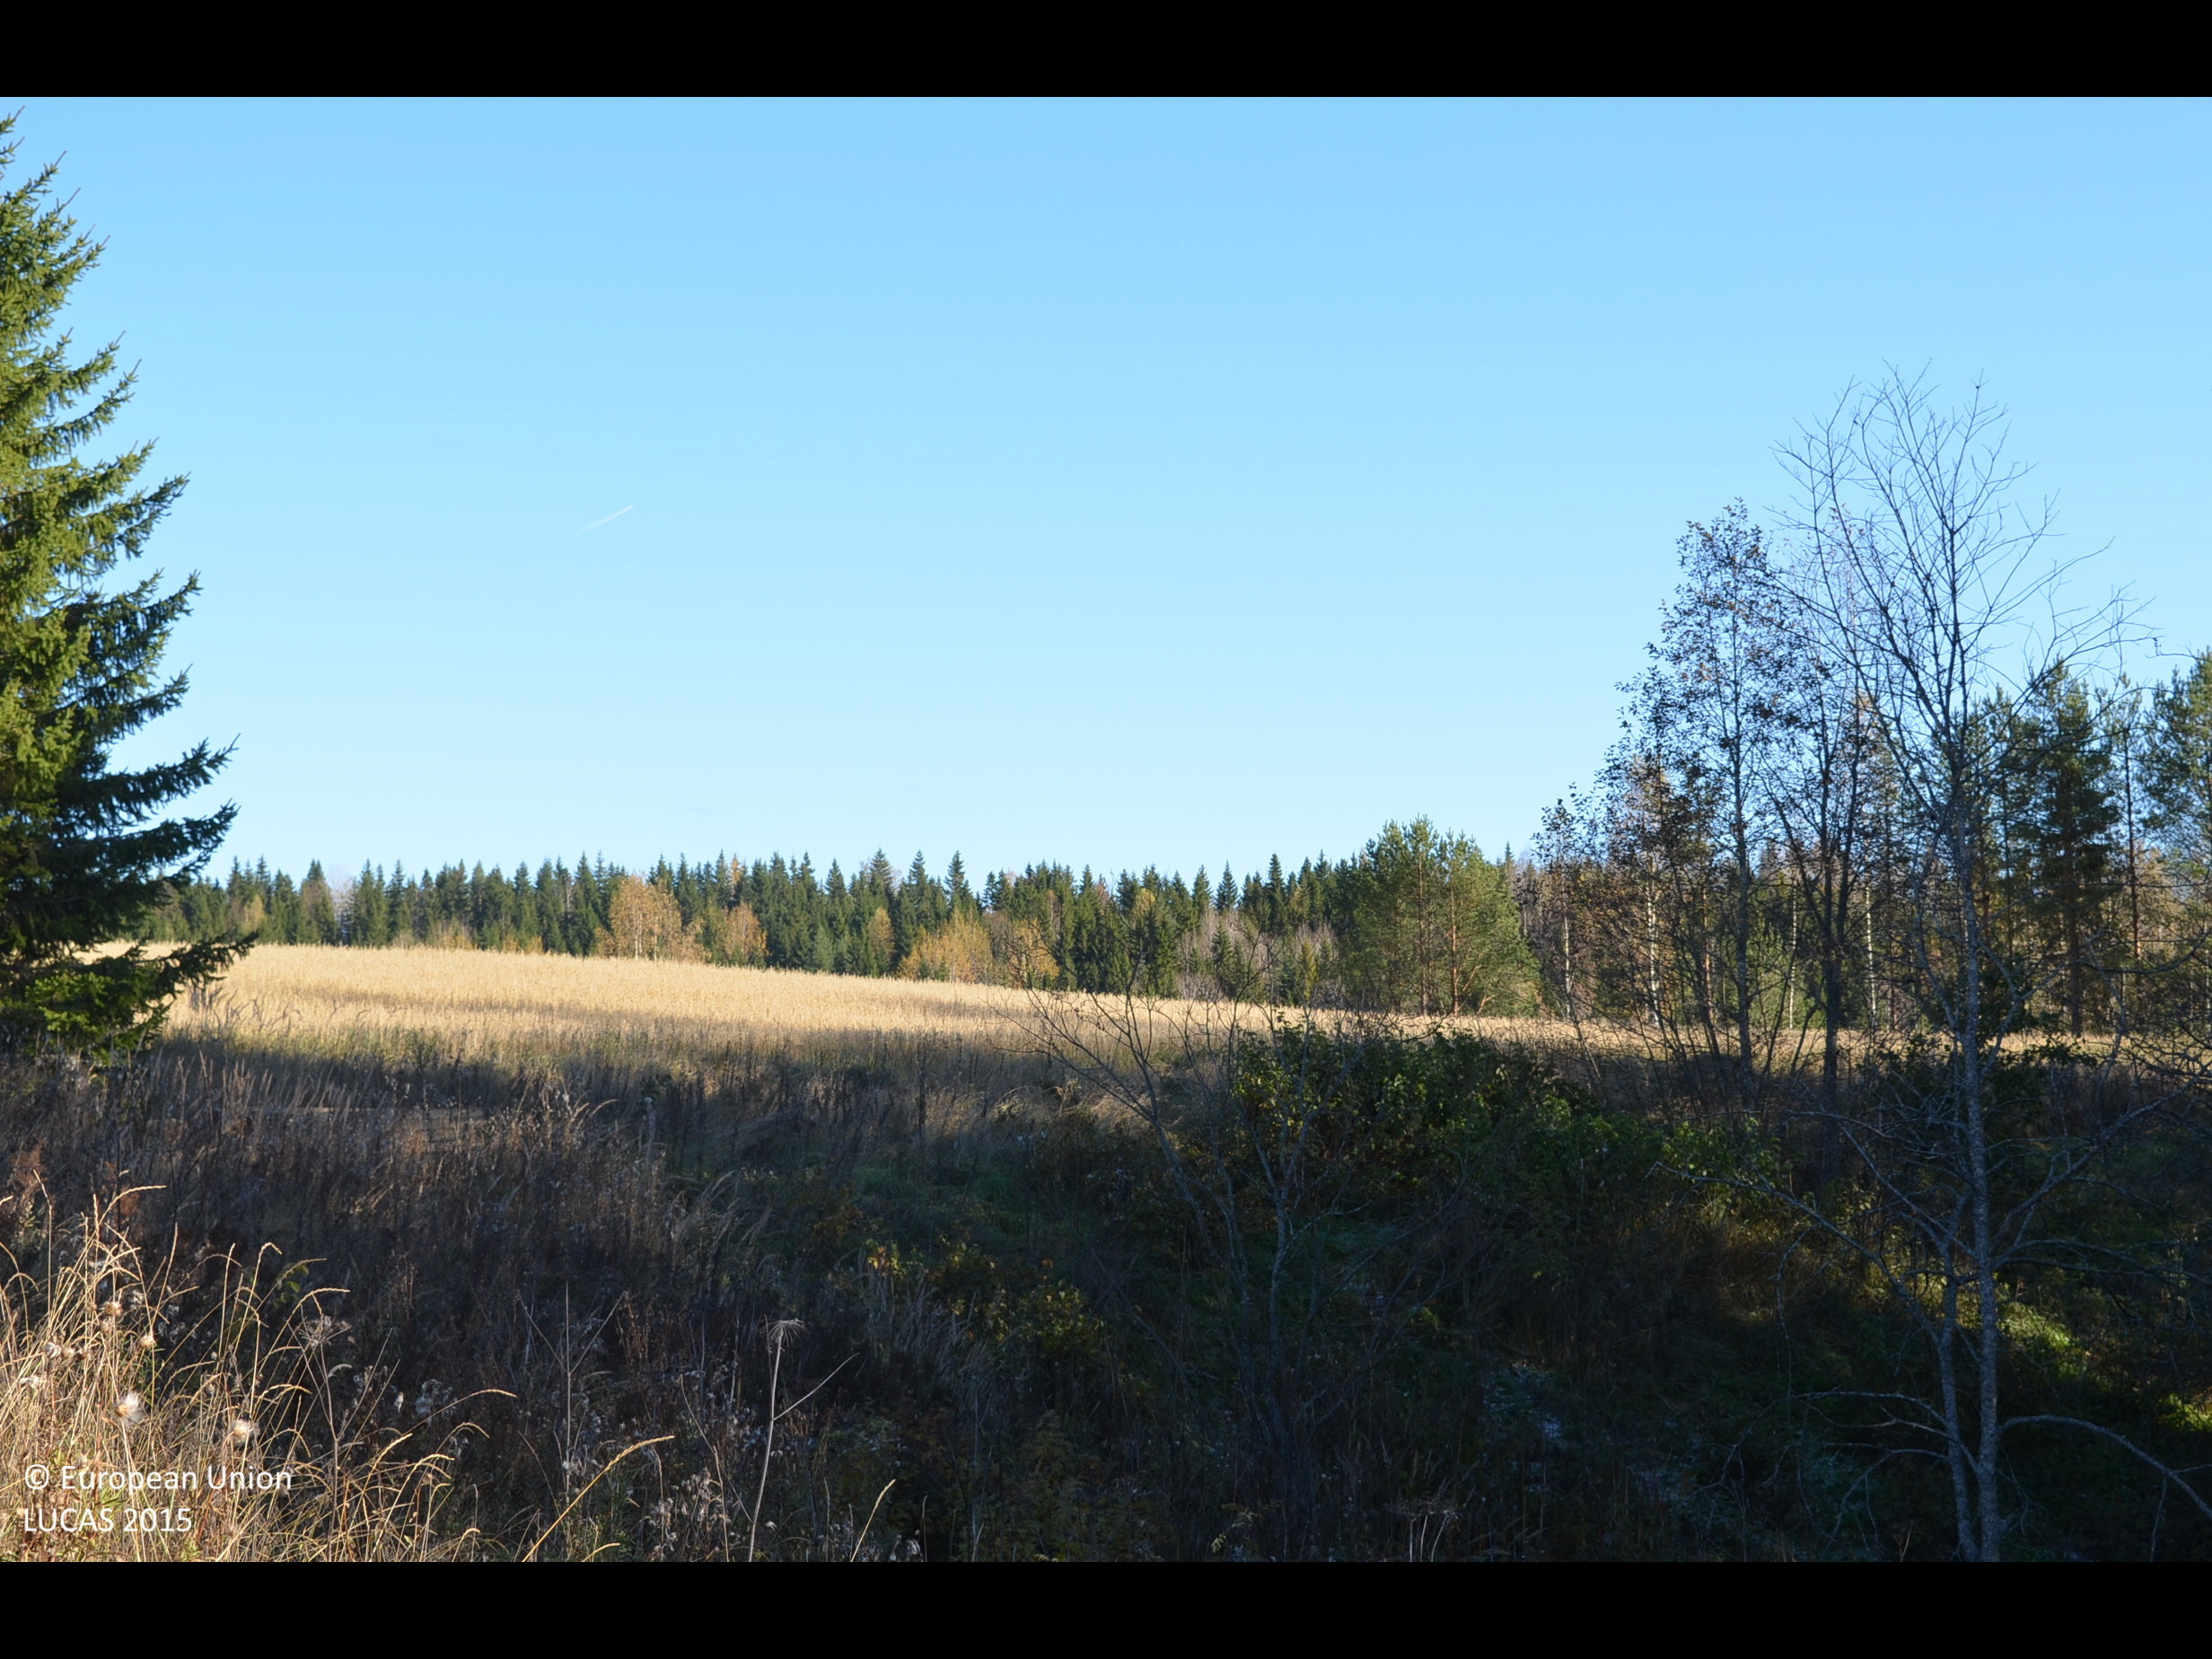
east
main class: Cropland
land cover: Oats
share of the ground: > 75 %
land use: Agriculture (excluding fallow land and kitchen gardens)
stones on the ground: < 10 %
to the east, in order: Oats; Electric lines; Grassland without tree/shrub cover; Single bushes/trees; Grassland without tree/shrub cover; Oats; Ditches and canals; Oats; Grassland without tree/shrub cover; Ditches and canals; Grass margins; Paved roads, cycling and walking lanes; Abandoned hedges; Grass margins; Fences; Temporary grasslands; Fences; Ditches and canals; Electric lines; Temporary grasslands
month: October
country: FI
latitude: 61.6448
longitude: 23.3827
